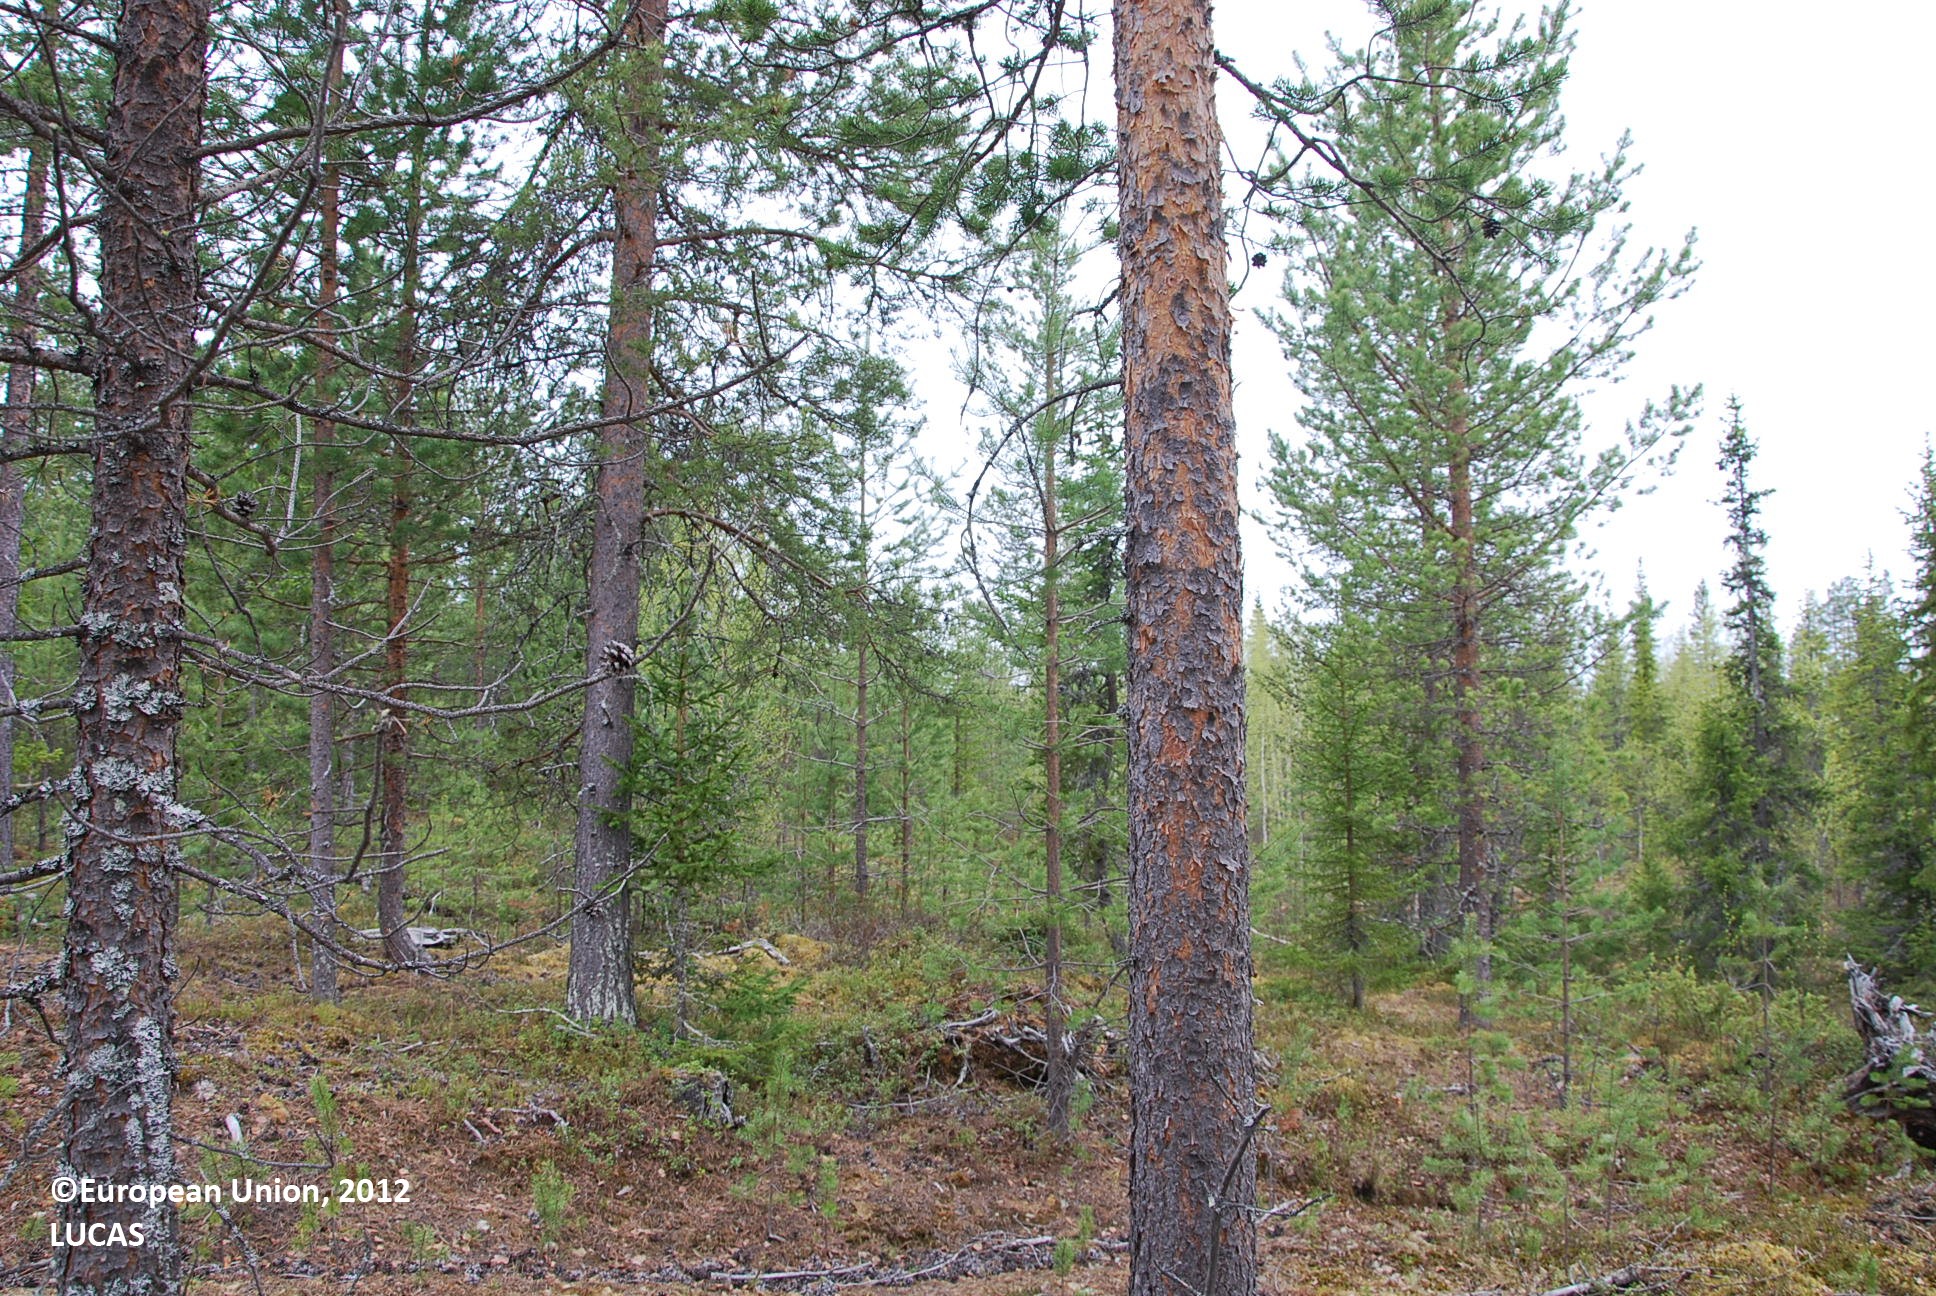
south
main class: Woodland
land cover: Pine dominated coniferous woodland
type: boreal forest
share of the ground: > 75 %
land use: Forestry
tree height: > 5 m
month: June
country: FI
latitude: 66.7874
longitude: 28.2066
